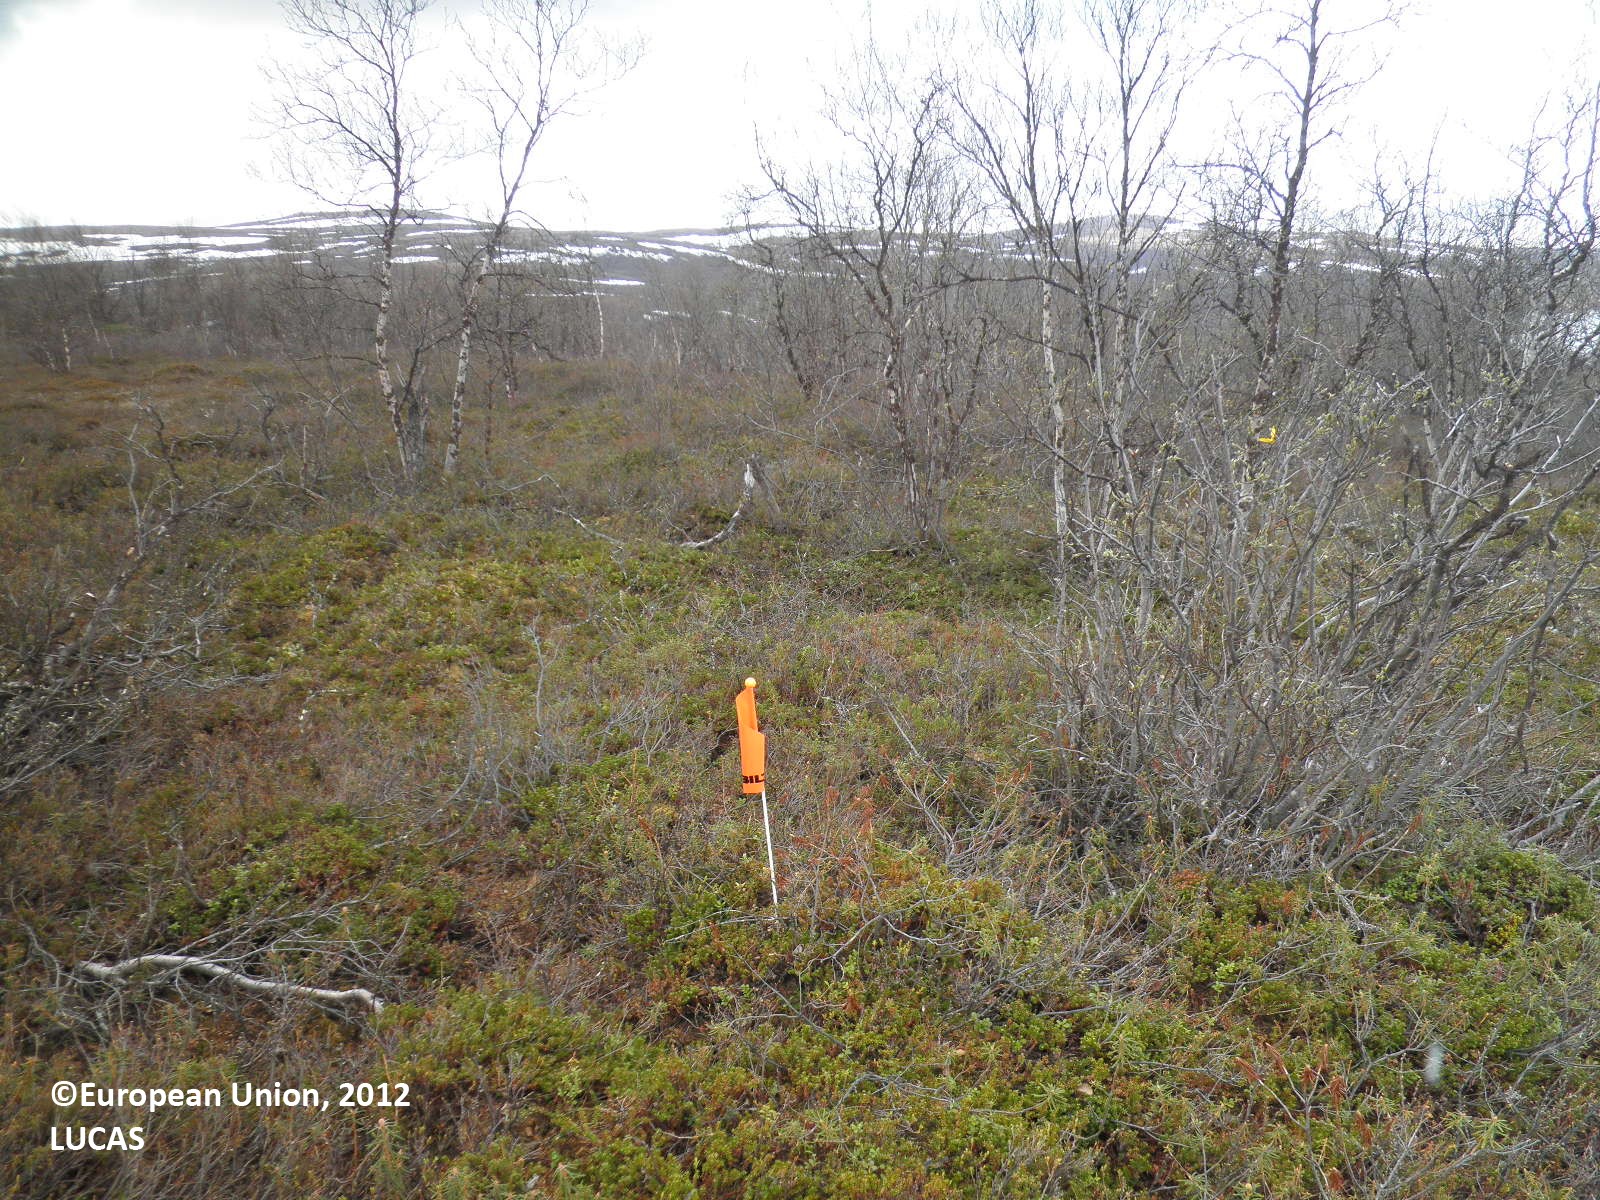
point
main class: Woodland
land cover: Broadleaved woodland
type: boreal forest
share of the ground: 10 - 25 %
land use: Forestry
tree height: < 5 m
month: May
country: FI
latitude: 70.0248
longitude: 27.5466
